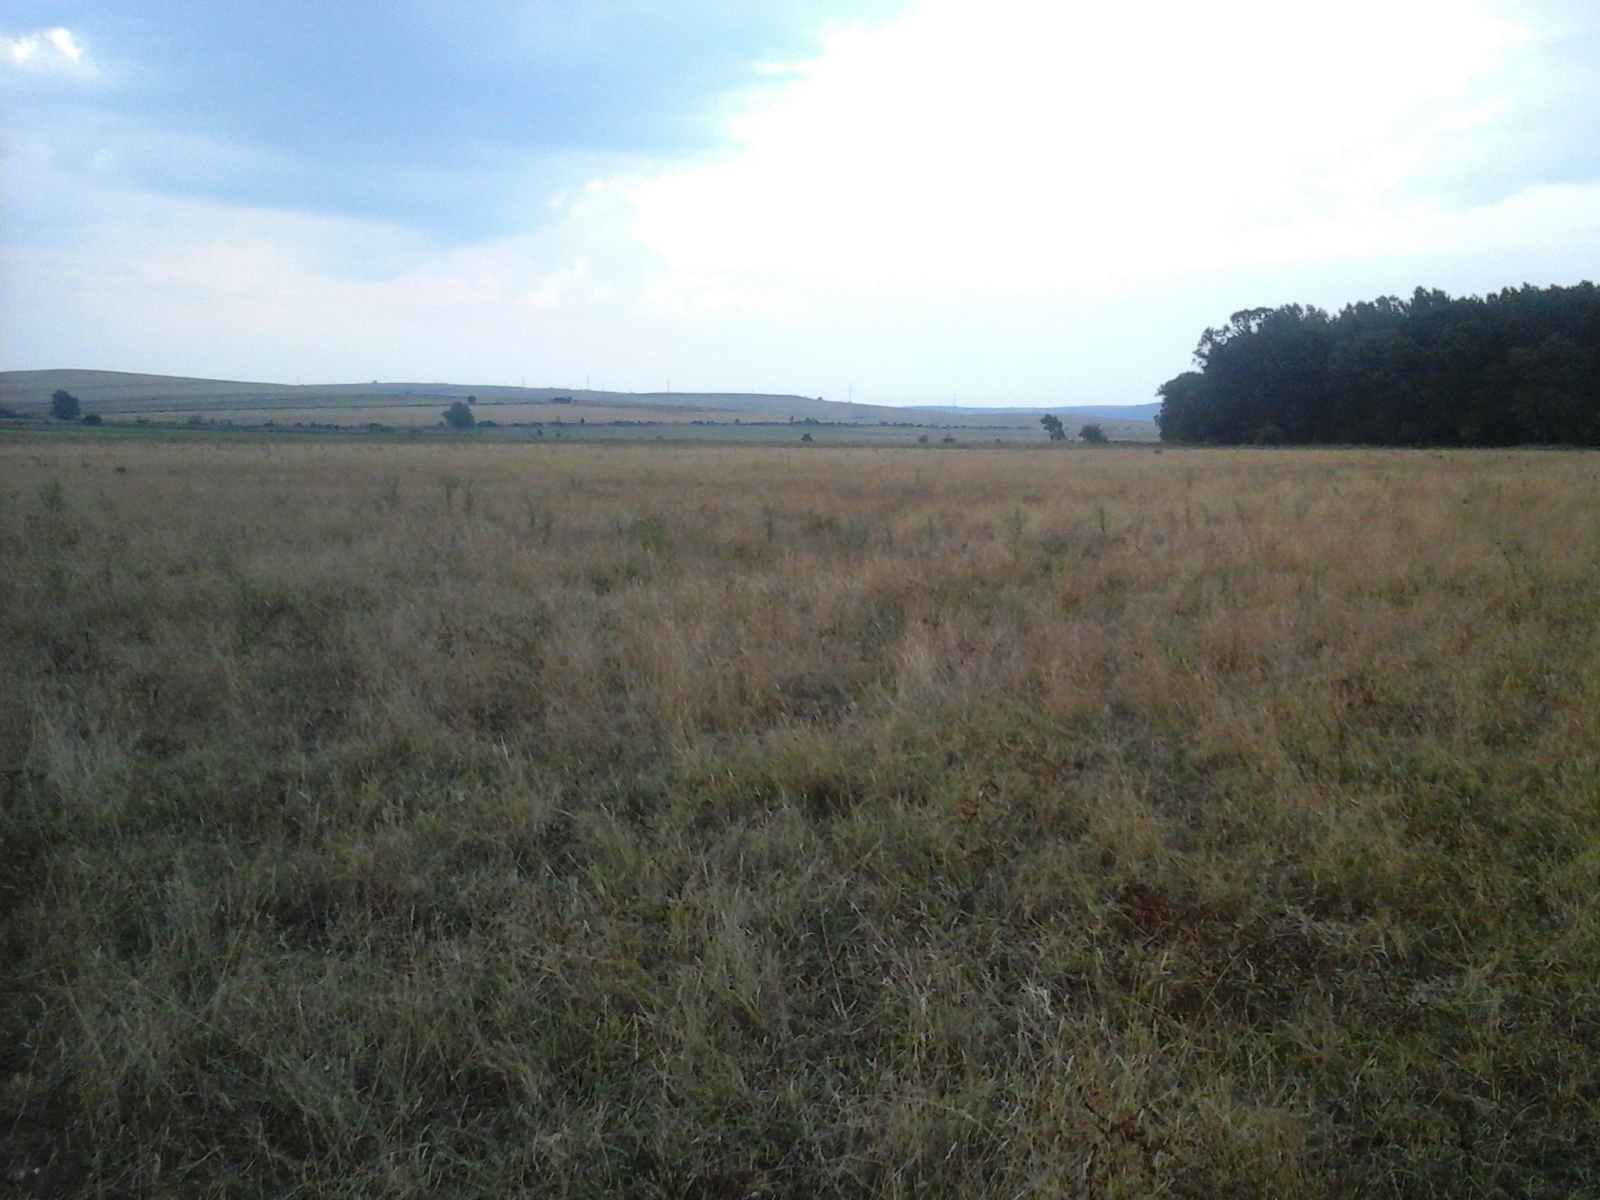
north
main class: Grassland
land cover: Grassland without tree/shrub cover
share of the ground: > 75 %
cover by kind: herbaceous plants 100 %
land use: Agriculture (excluding fallow land and kitchen gardens)
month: August
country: RO
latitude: 44.4809
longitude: 22.8294
